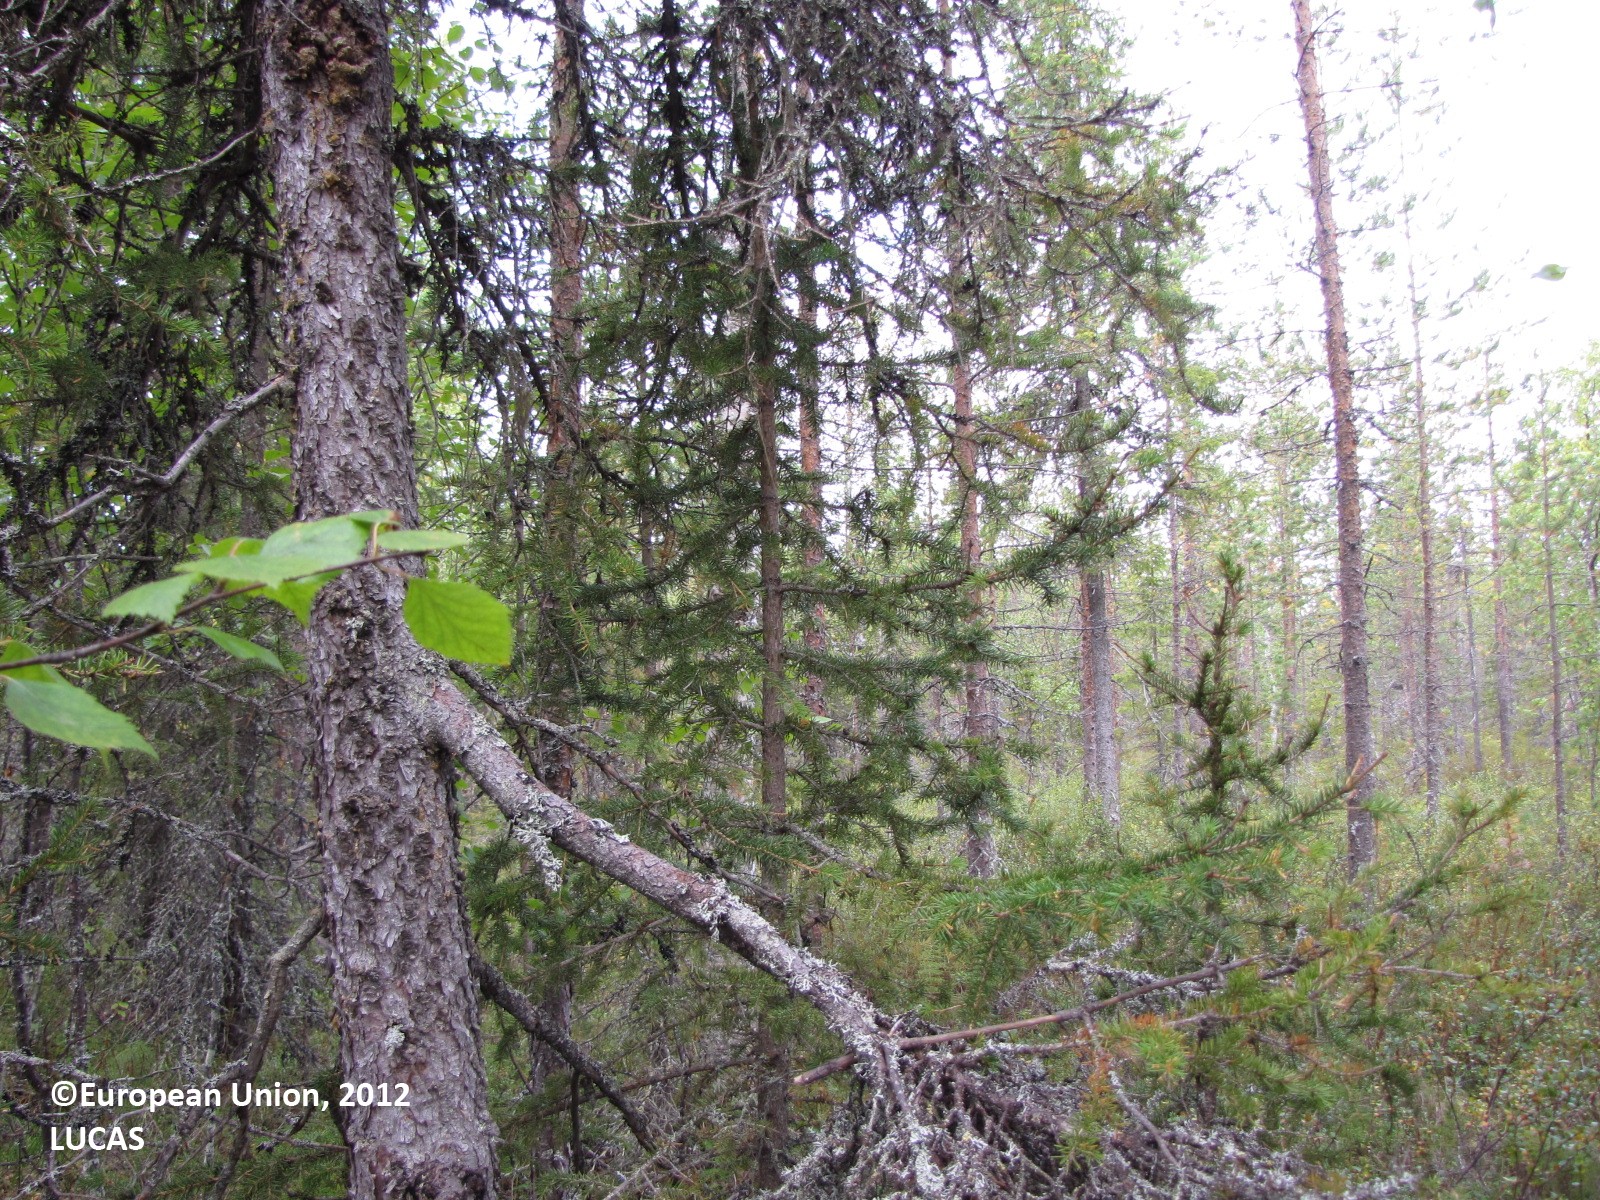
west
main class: Woodland
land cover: Pine dominated mixed woodland
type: boreal forest
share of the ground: > 75 %
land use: Forestry
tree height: > 5 m
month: August
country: FI
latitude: 67.1322
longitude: 25.0579
